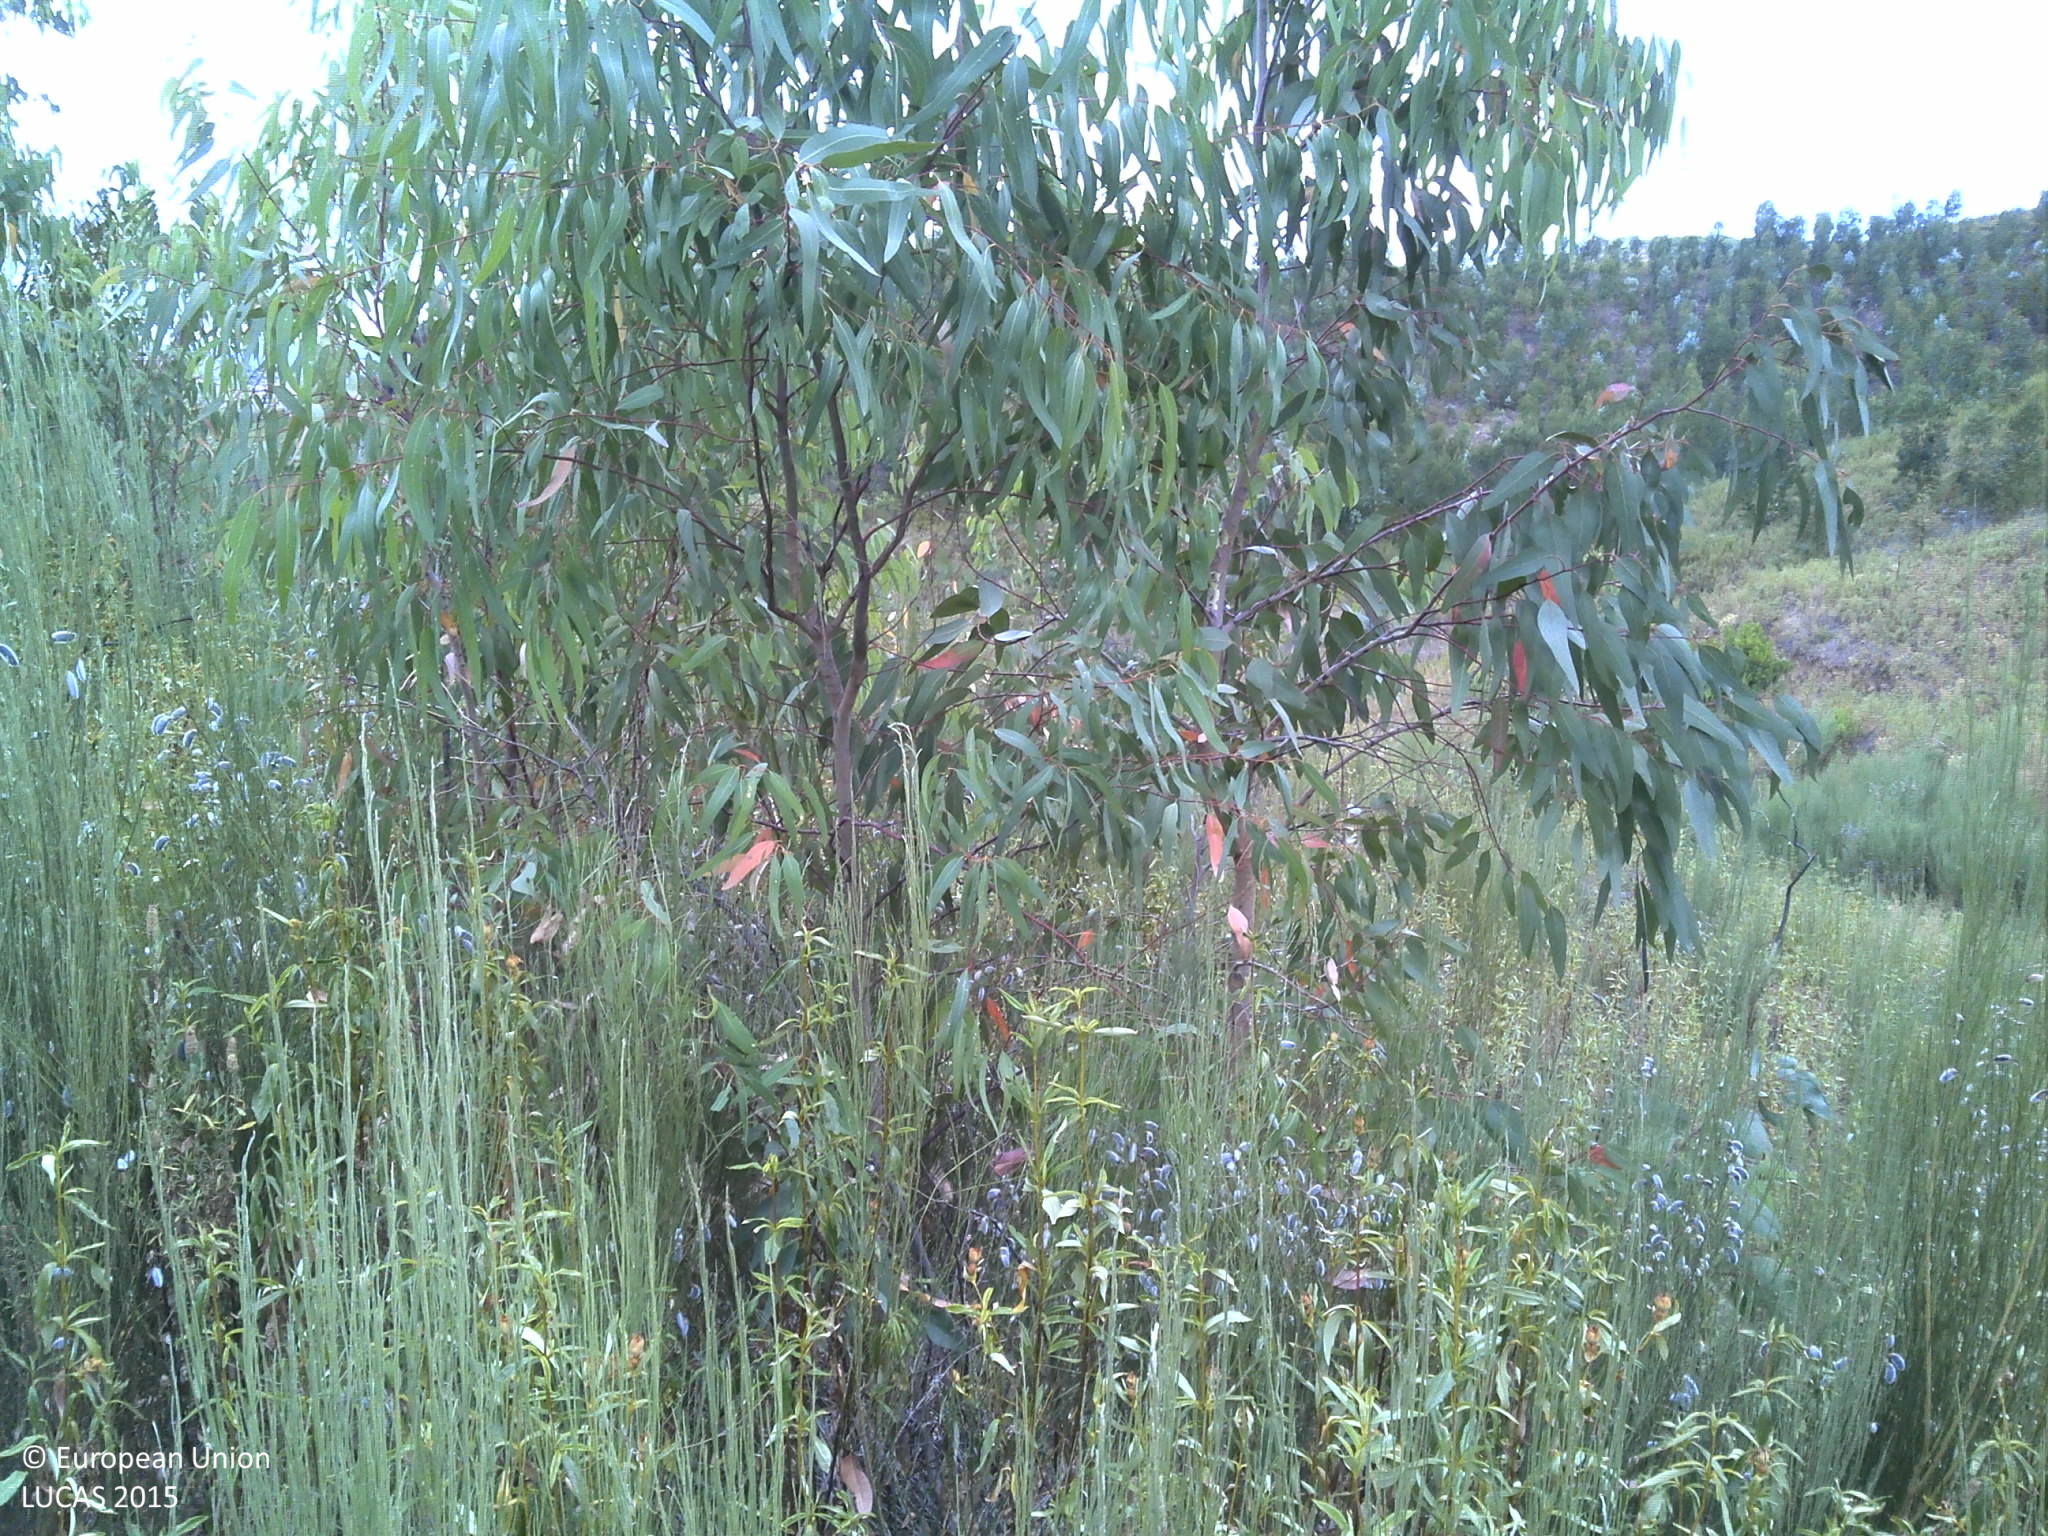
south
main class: Woodland
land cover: Broadleaved woodland
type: exotic forest
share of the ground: 10 - 25 %
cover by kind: shrubs 45 %, broadleaved forest trees 25 %, unconsolidated bare surface 20 %, herbaceous plants 10 %
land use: Forestry
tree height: < 5 m
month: June
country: PT
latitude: 37.3026
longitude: -7.8495
